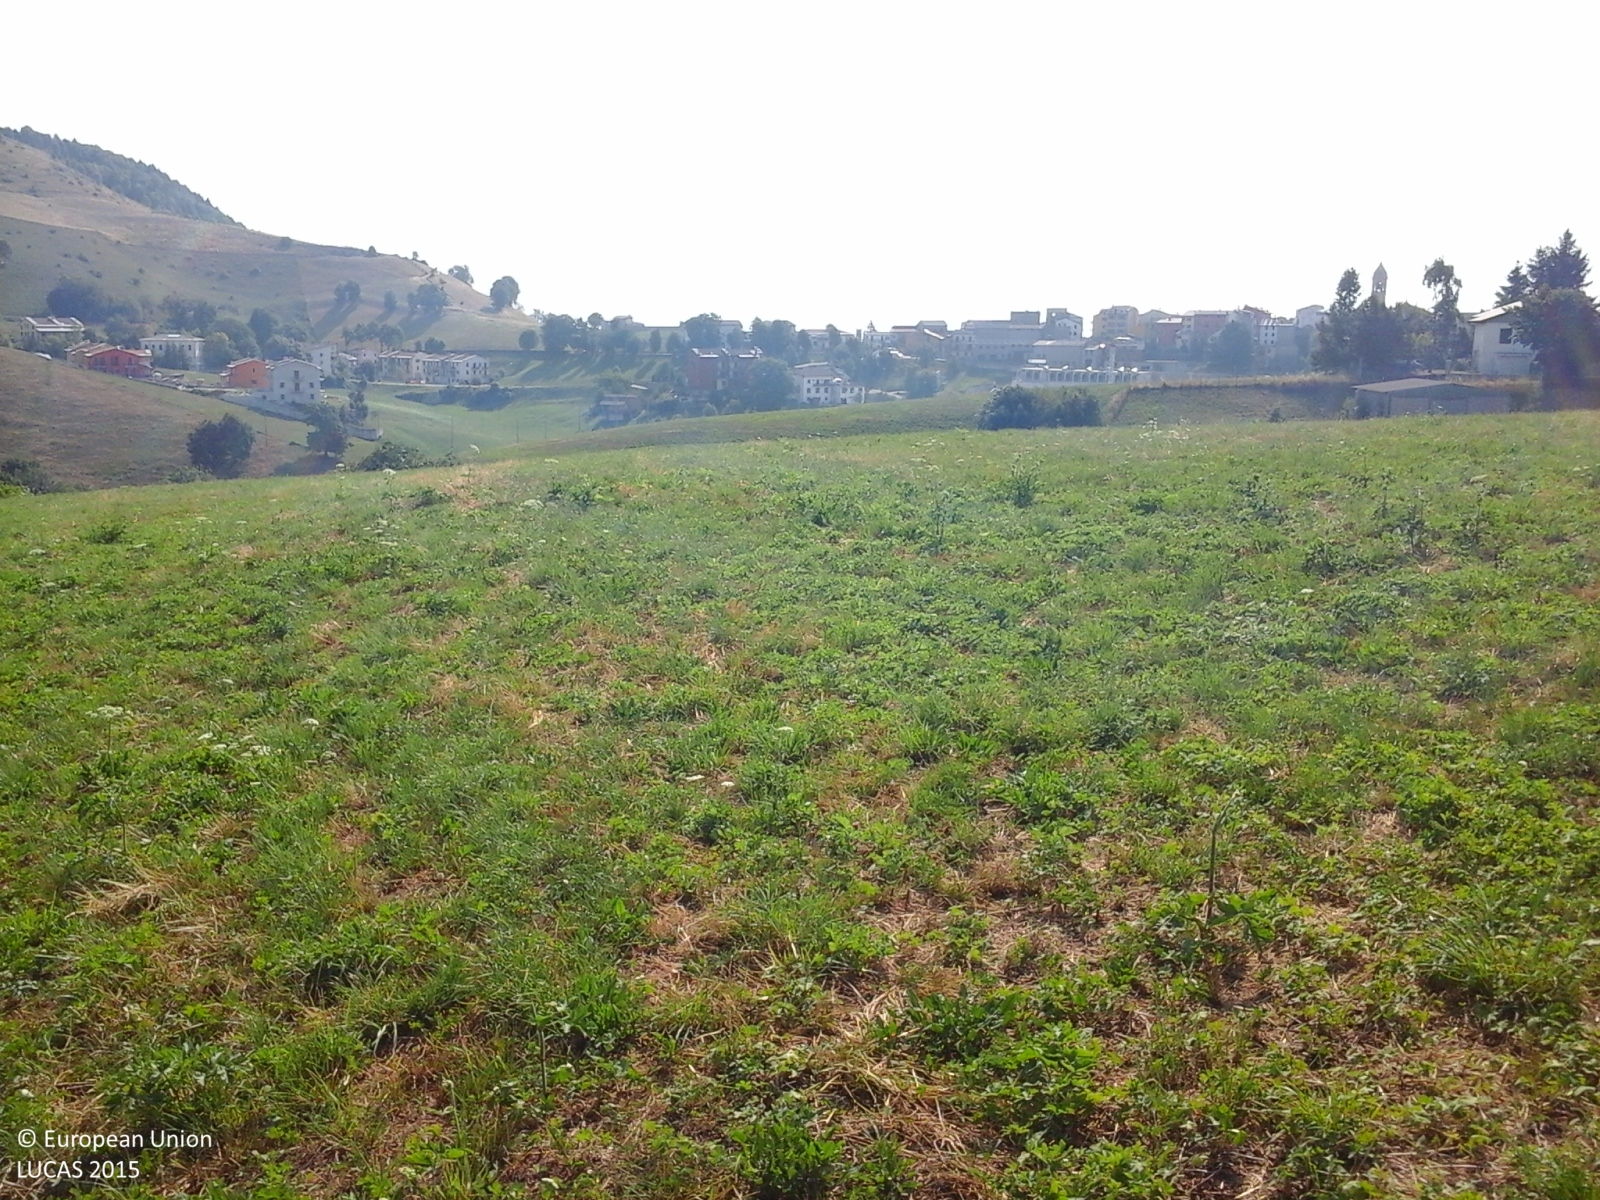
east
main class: Grassland
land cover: Grassland without tree/shrub cover
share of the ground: > 75 %
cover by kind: herbaceous plants 100 %
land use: Agriculture (excluding fallow land and kitchen gardens)
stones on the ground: < 10 %
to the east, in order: Grassland without tree/shrub cover; Dry stone walls; Tracks; Dry stone walls; Lines of trees; Grassland without tree/shrub cover
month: July
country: IT
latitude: 45.6069
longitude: 11.0881
